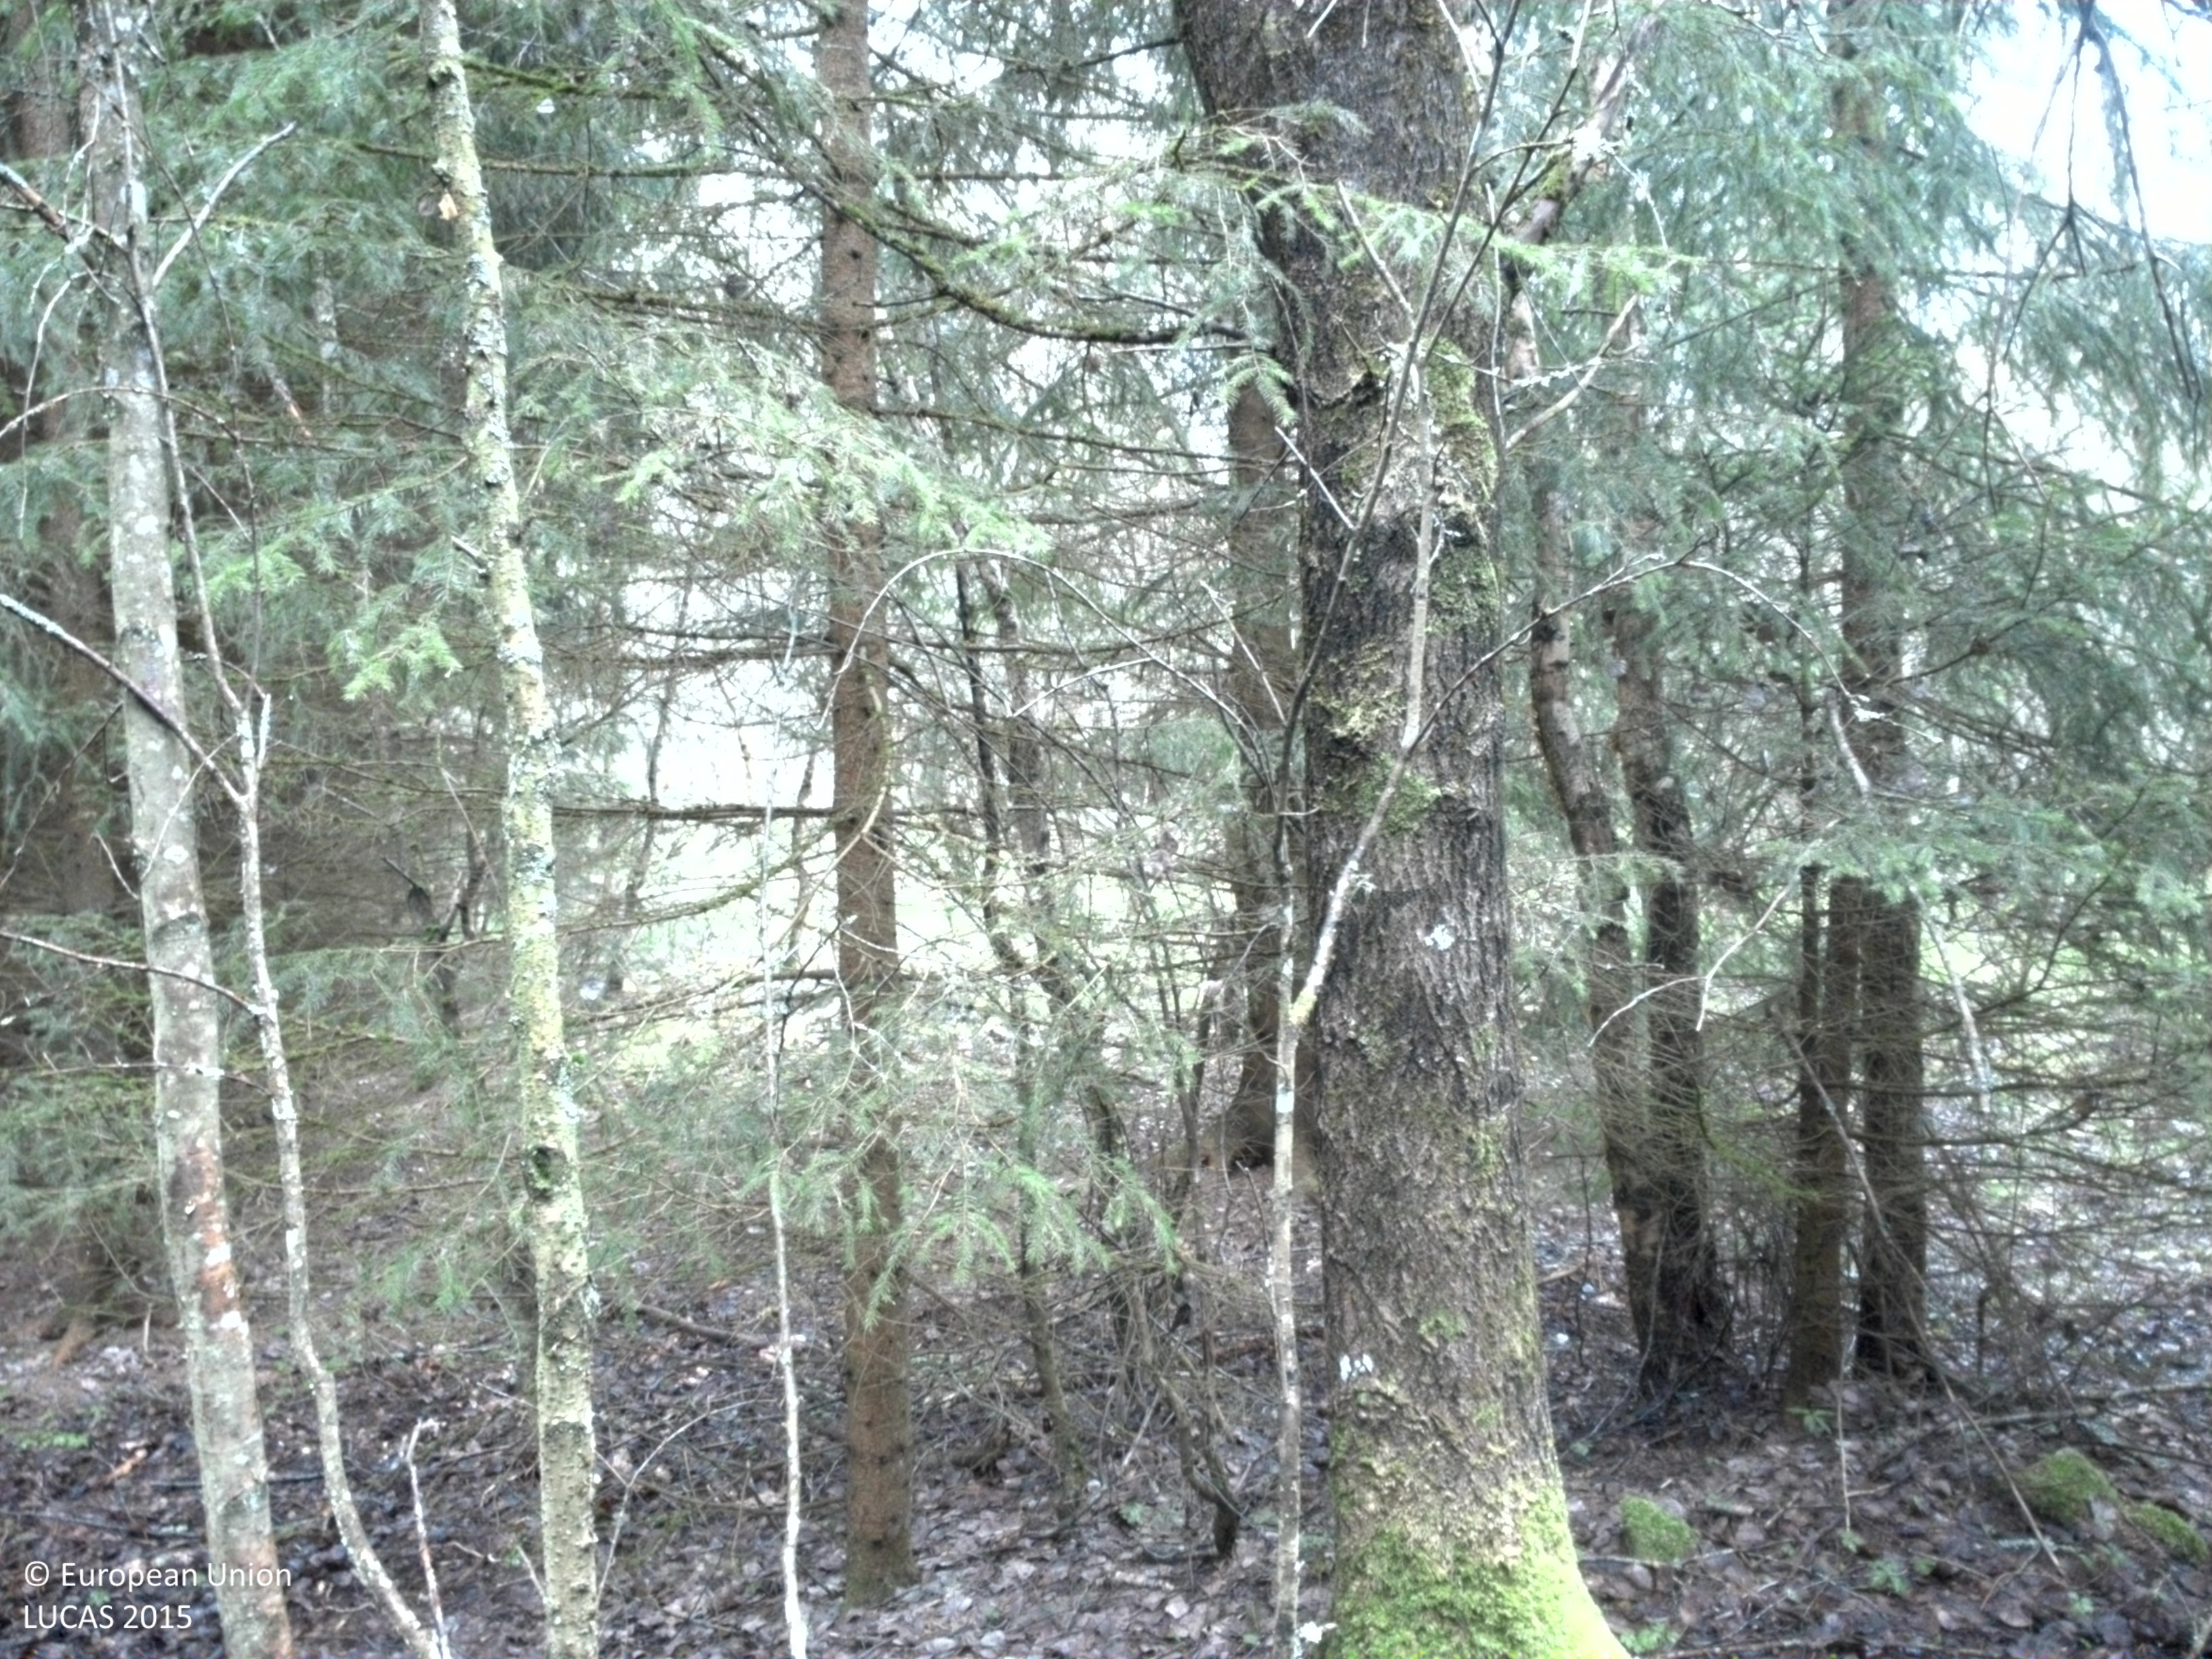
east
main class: Woodland
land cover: Spruce dominated mixed woodland
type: boreal forest
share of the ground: > 75 %
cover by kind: coniferous forest trees 40 %, broadleaved forest trees 40 %, lichens and mosses 20 %
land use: Forestry
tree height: > 5 m
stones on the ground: < 10 %
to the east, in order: Spruce dominated mixed woodland; Broadleaved woodland; Ditches and canals; Grassland with sparse tree/shrub cover; Broadleaved woodland; Grassland without tree/shrub cover; Groves; Grassland with sparse tree/shrub cover; Broadleaved woodland
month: May
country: SE
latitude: 56.6820
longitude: 15.0745
